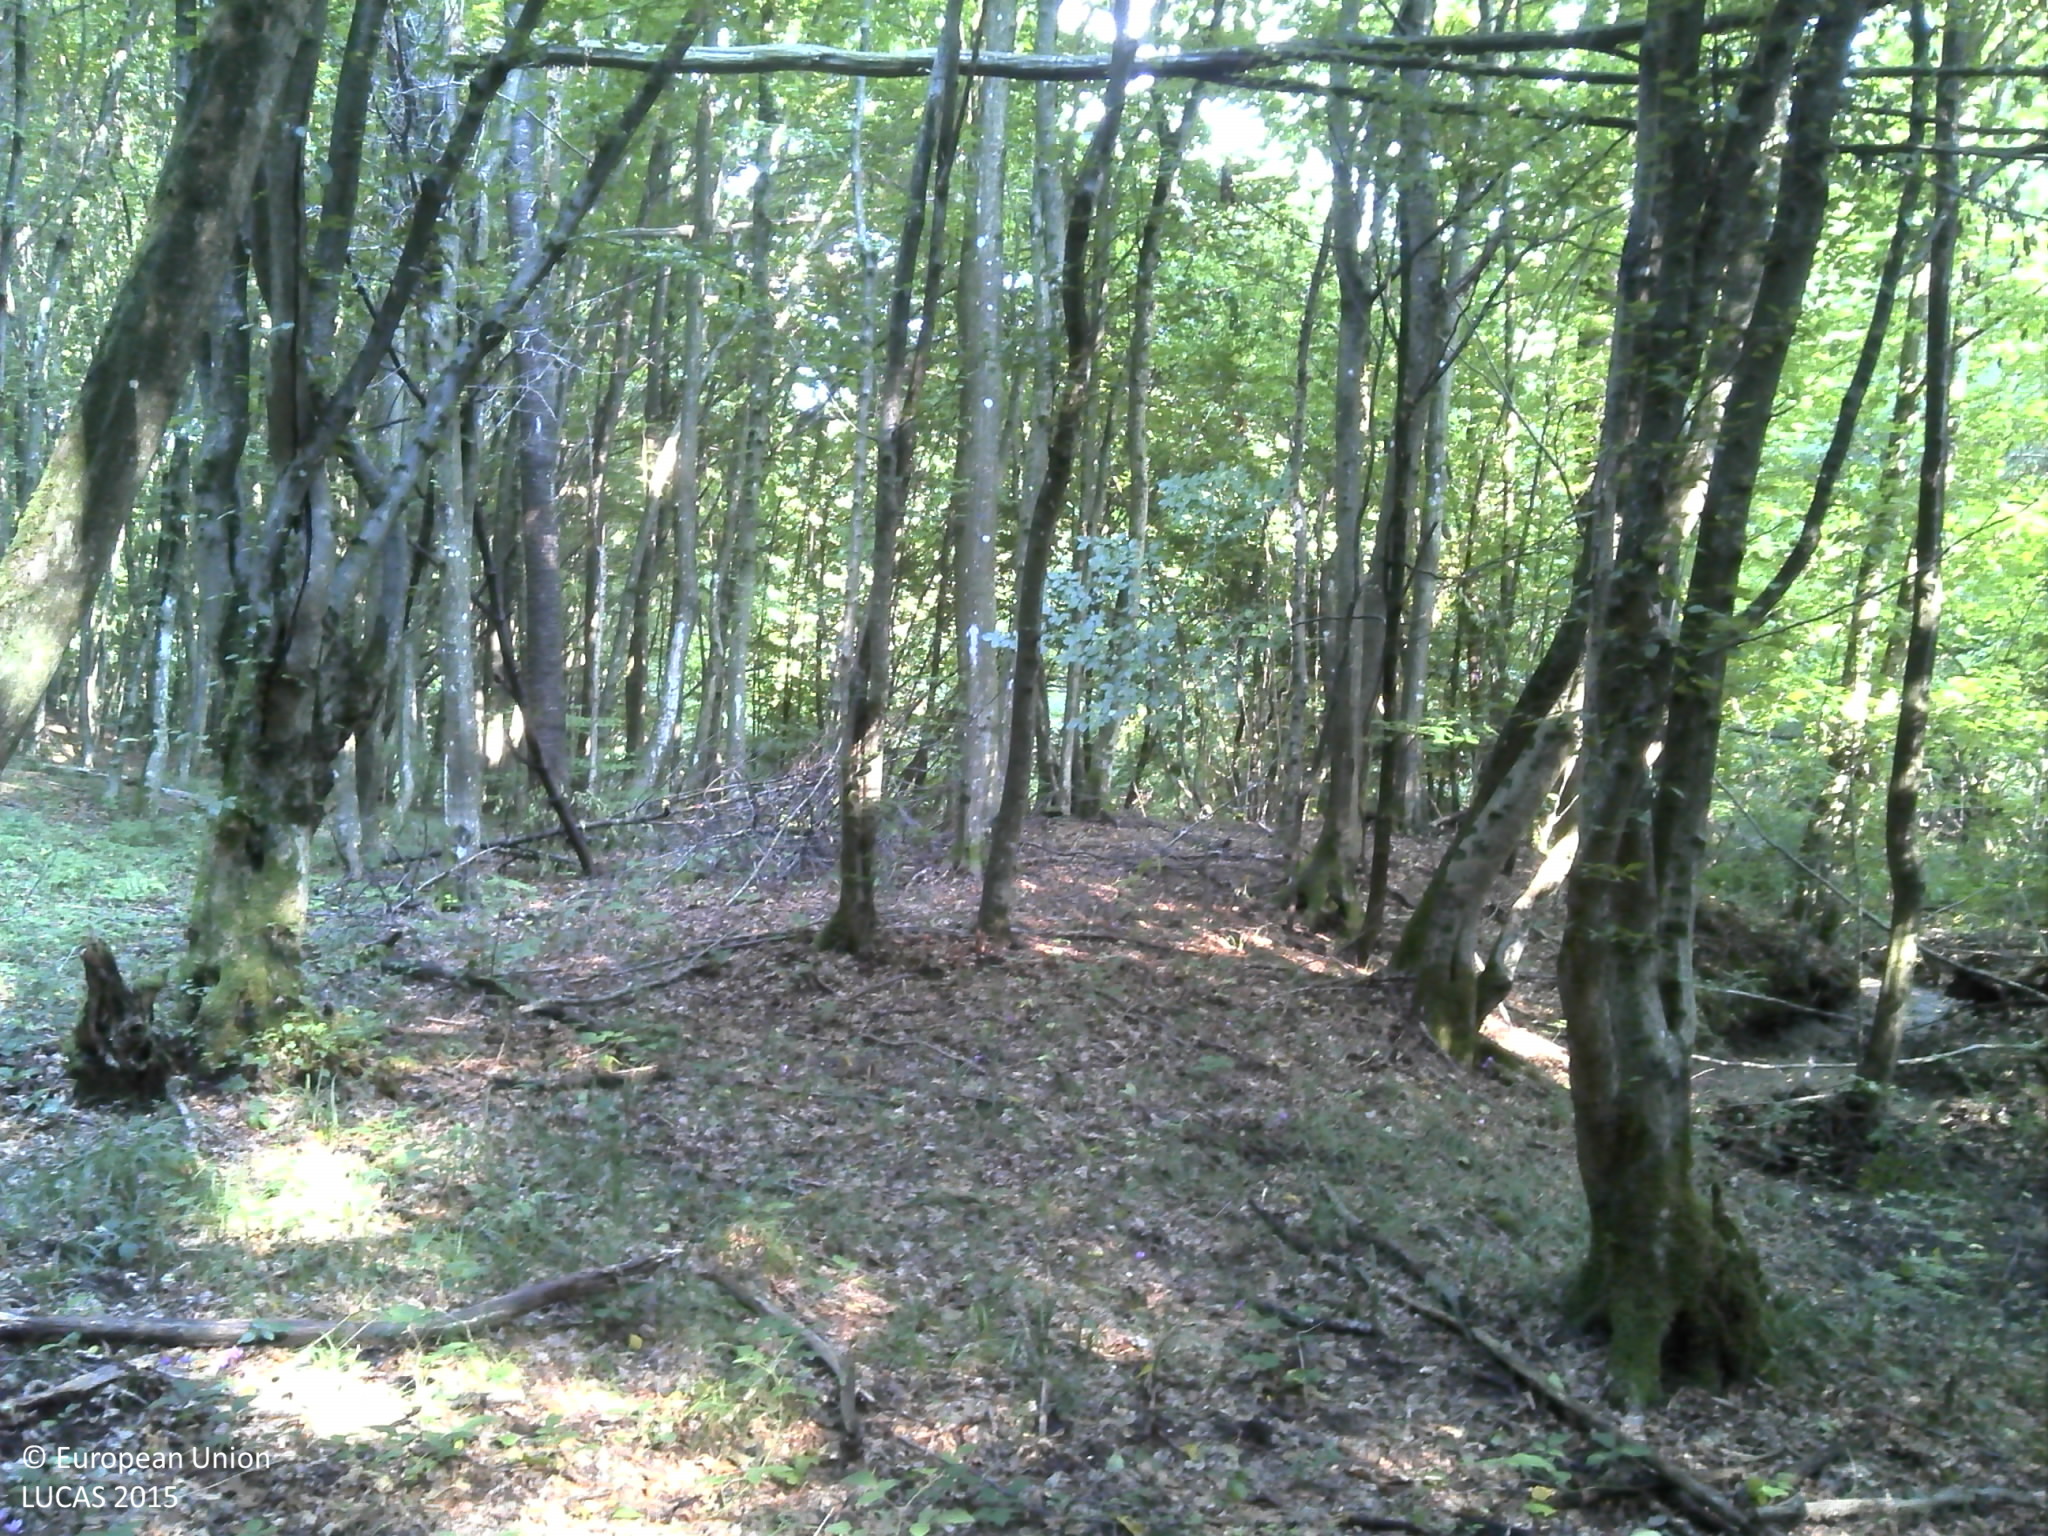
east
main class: Woodland
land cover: Broadleaved woodland
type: beech forest
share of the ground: > 75 %
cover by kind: broadleaved forest trees 100 %
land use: Forestry
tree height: > 5 m
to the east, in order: Broadleaved woodland; Rivers and streams; Broadleaved woodland
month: August
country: HR
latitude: 45.2641
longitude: 16.5610
